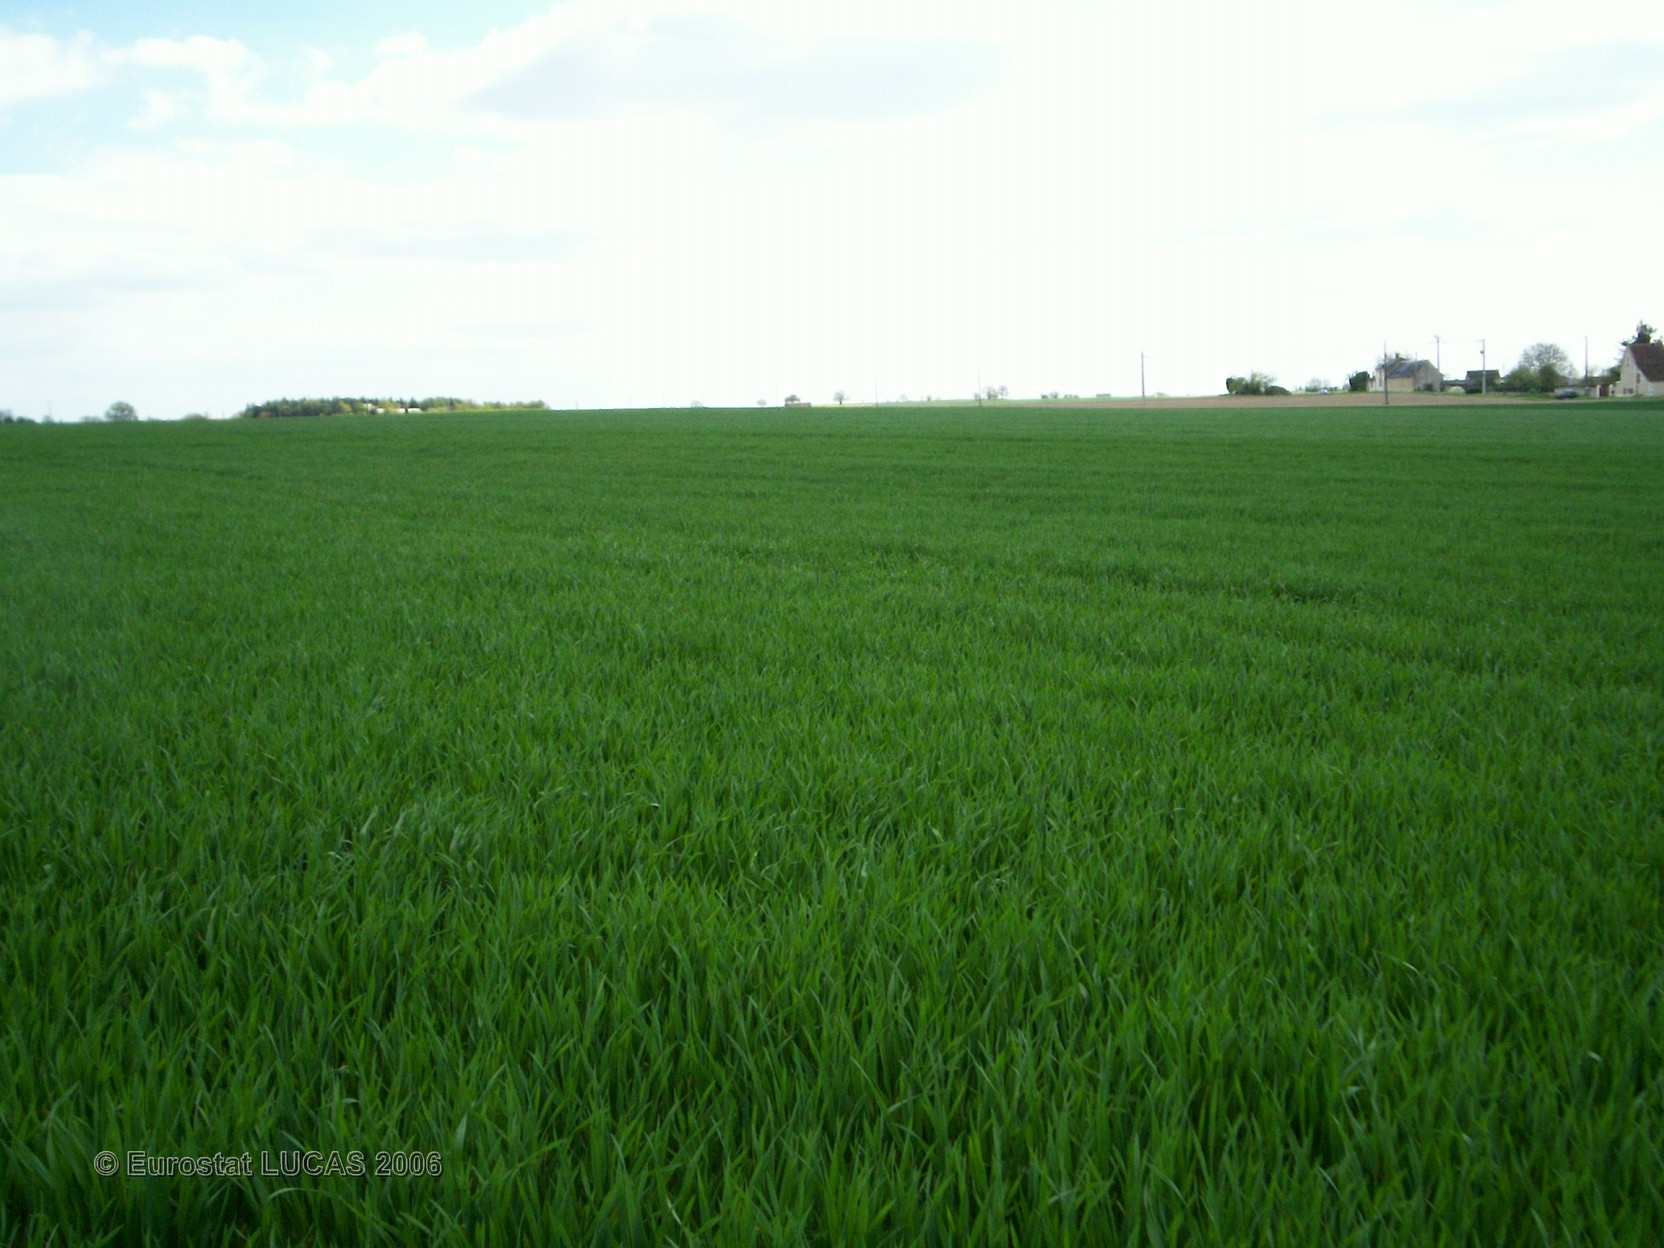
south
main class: Cropland
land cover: Common wheat
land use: Agriculture (excluding fallow land and kitchen gardens)
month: April
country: FR
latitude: 47.1340
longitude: 0.2080
